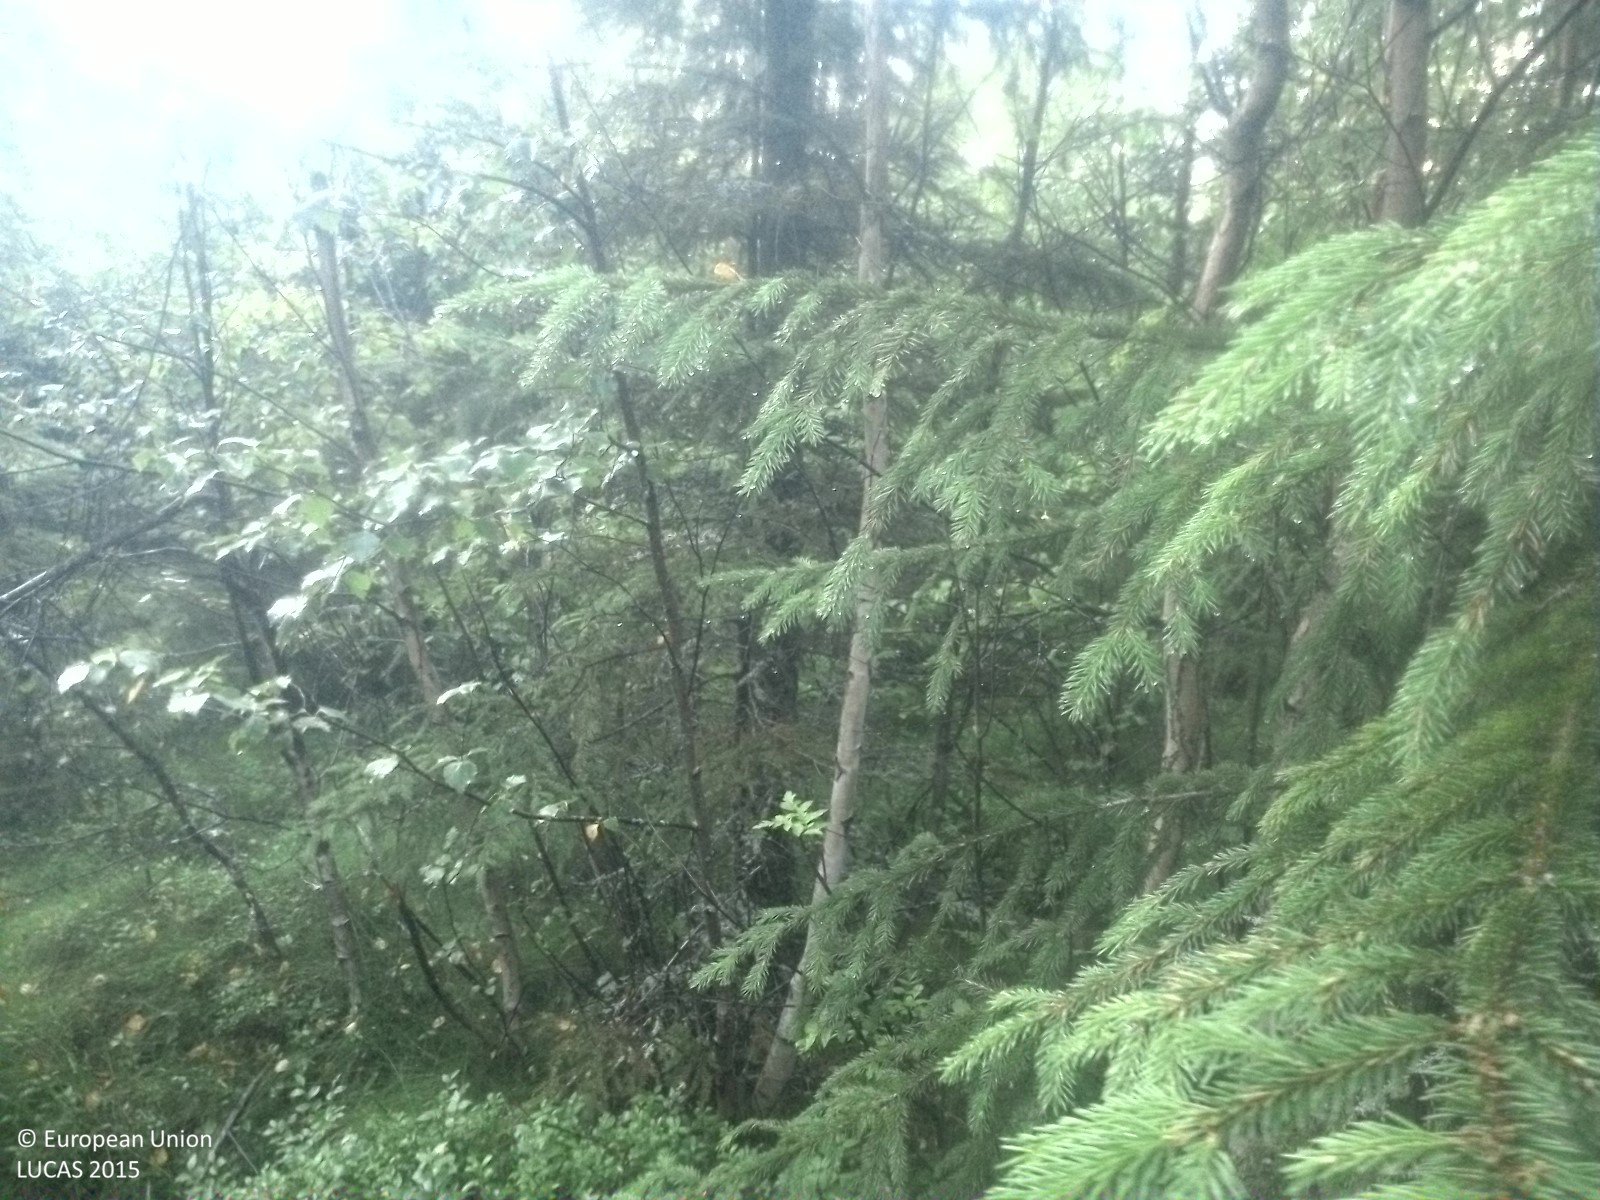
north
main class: Woodland
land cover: Spruce dominated mixed woodland
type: boreal forest
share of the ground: > 75 %
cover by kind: coniferous forest trees 45 %, broadleaved forest trees 30 %, herbaceous plants 25 %
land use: Forestry
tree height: > 5 m
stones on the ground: < 10 %
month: August
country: SE
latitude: 62.6173
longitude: 16.8973
